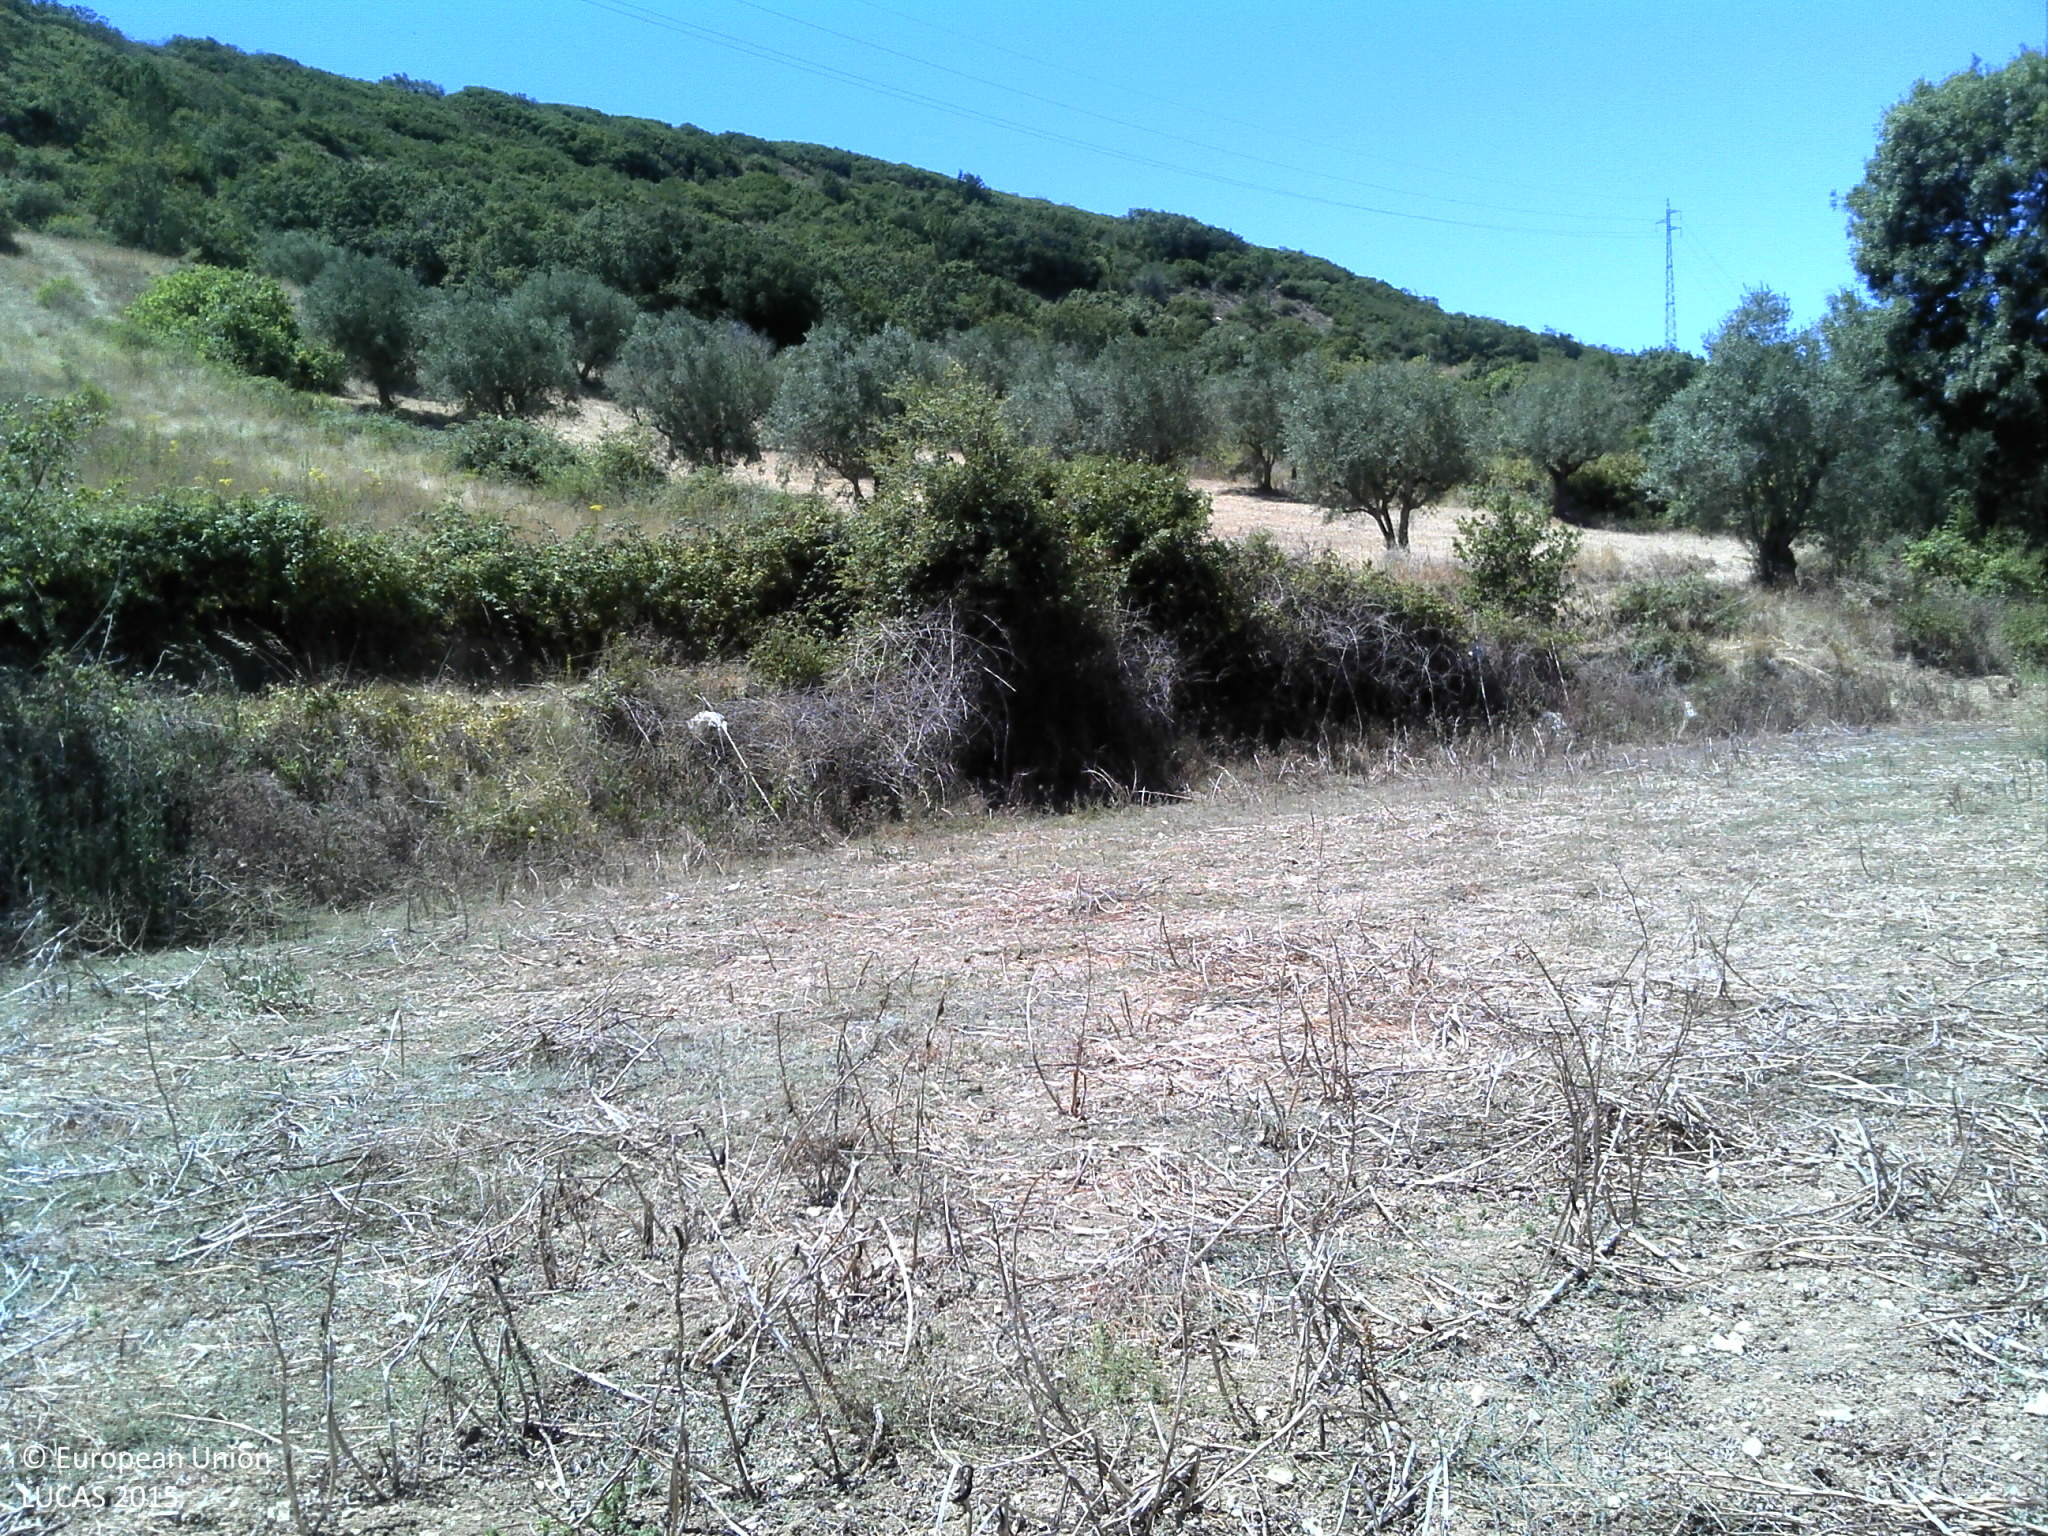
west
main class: Shrubland
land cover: Shrubland with sparse tree cover
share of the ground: 50 - 75 %
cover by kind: shrubs 50 %, herbaceous plants 25 %, coniferous forest trees 5 %, unconsolidated bare surface 5 %
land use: Forestry
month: July
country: PT
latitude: 38.9486
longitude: -9.1769
